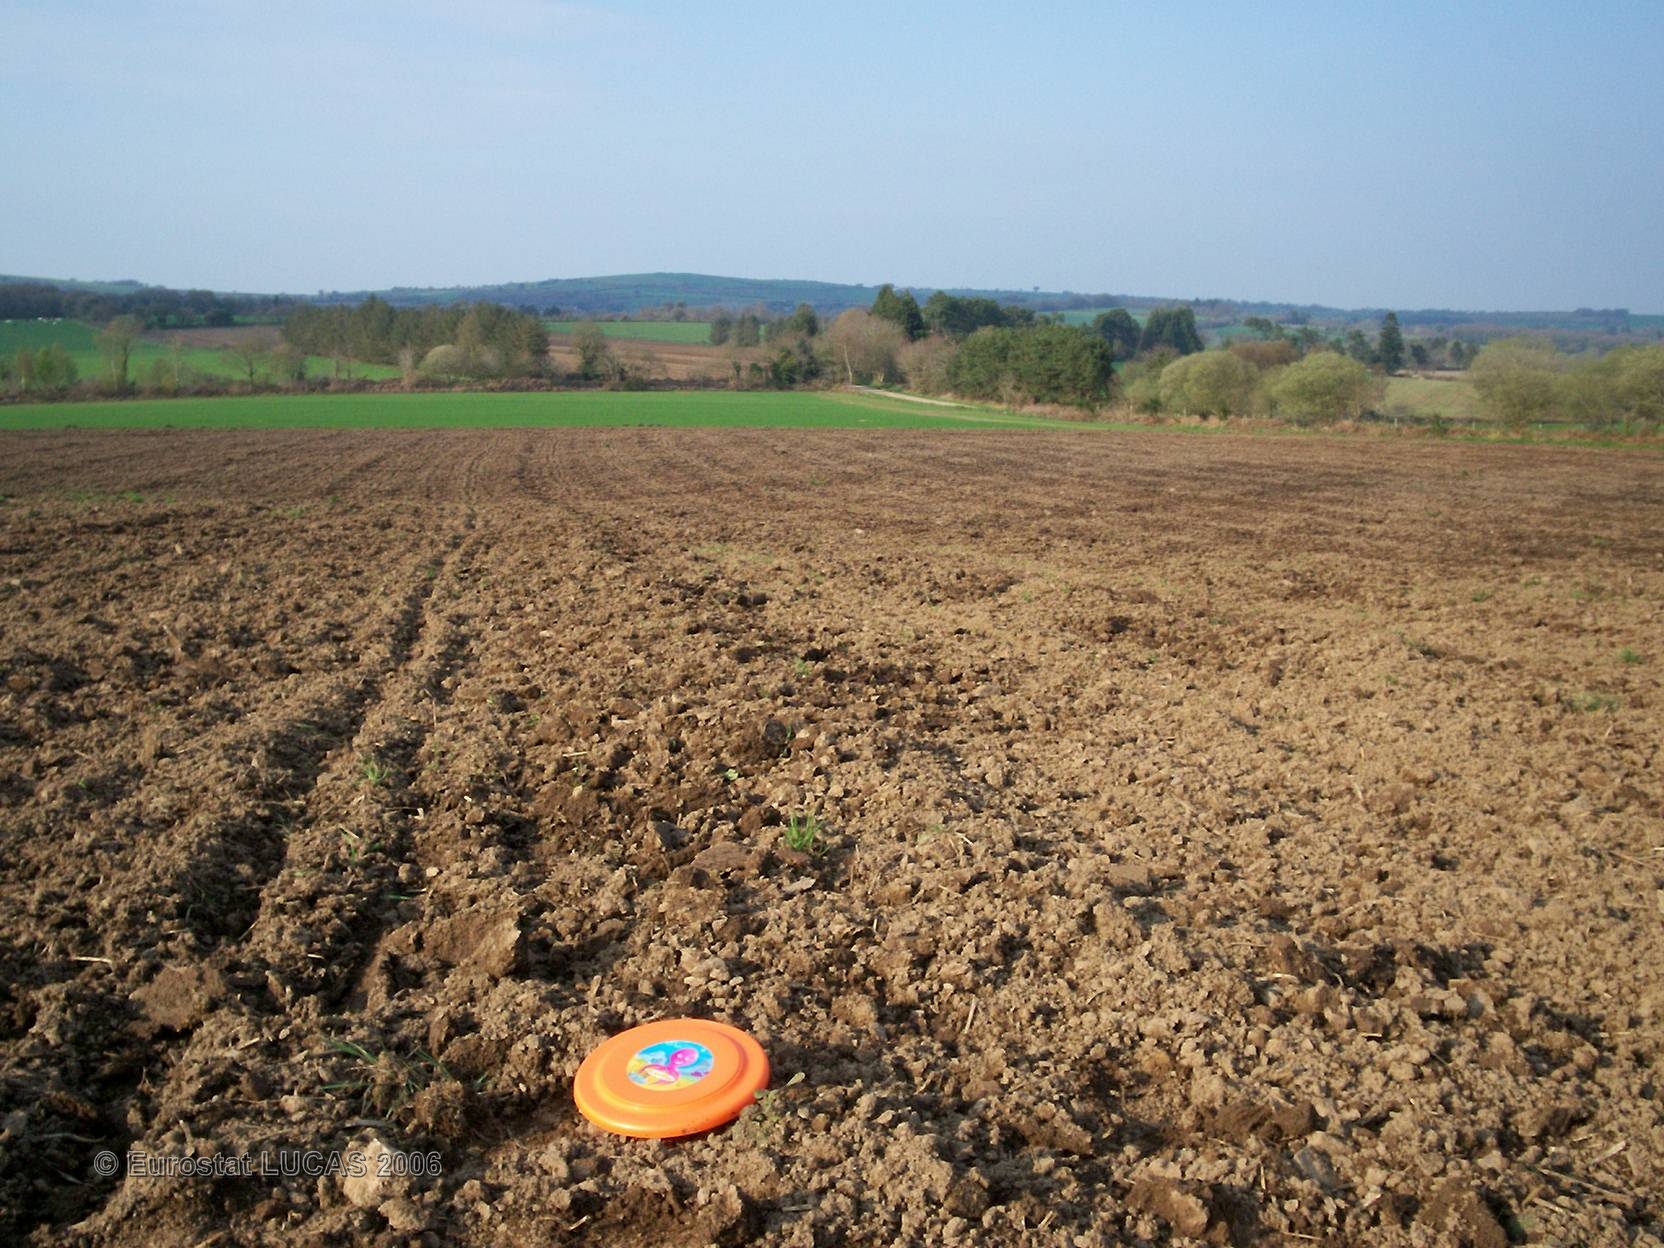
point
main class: Cropland
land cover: Maize
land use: Agriculture (excluding fallow land and kitchen gardens)
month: June
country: FR
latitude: 48.4581
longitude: -3.6998
